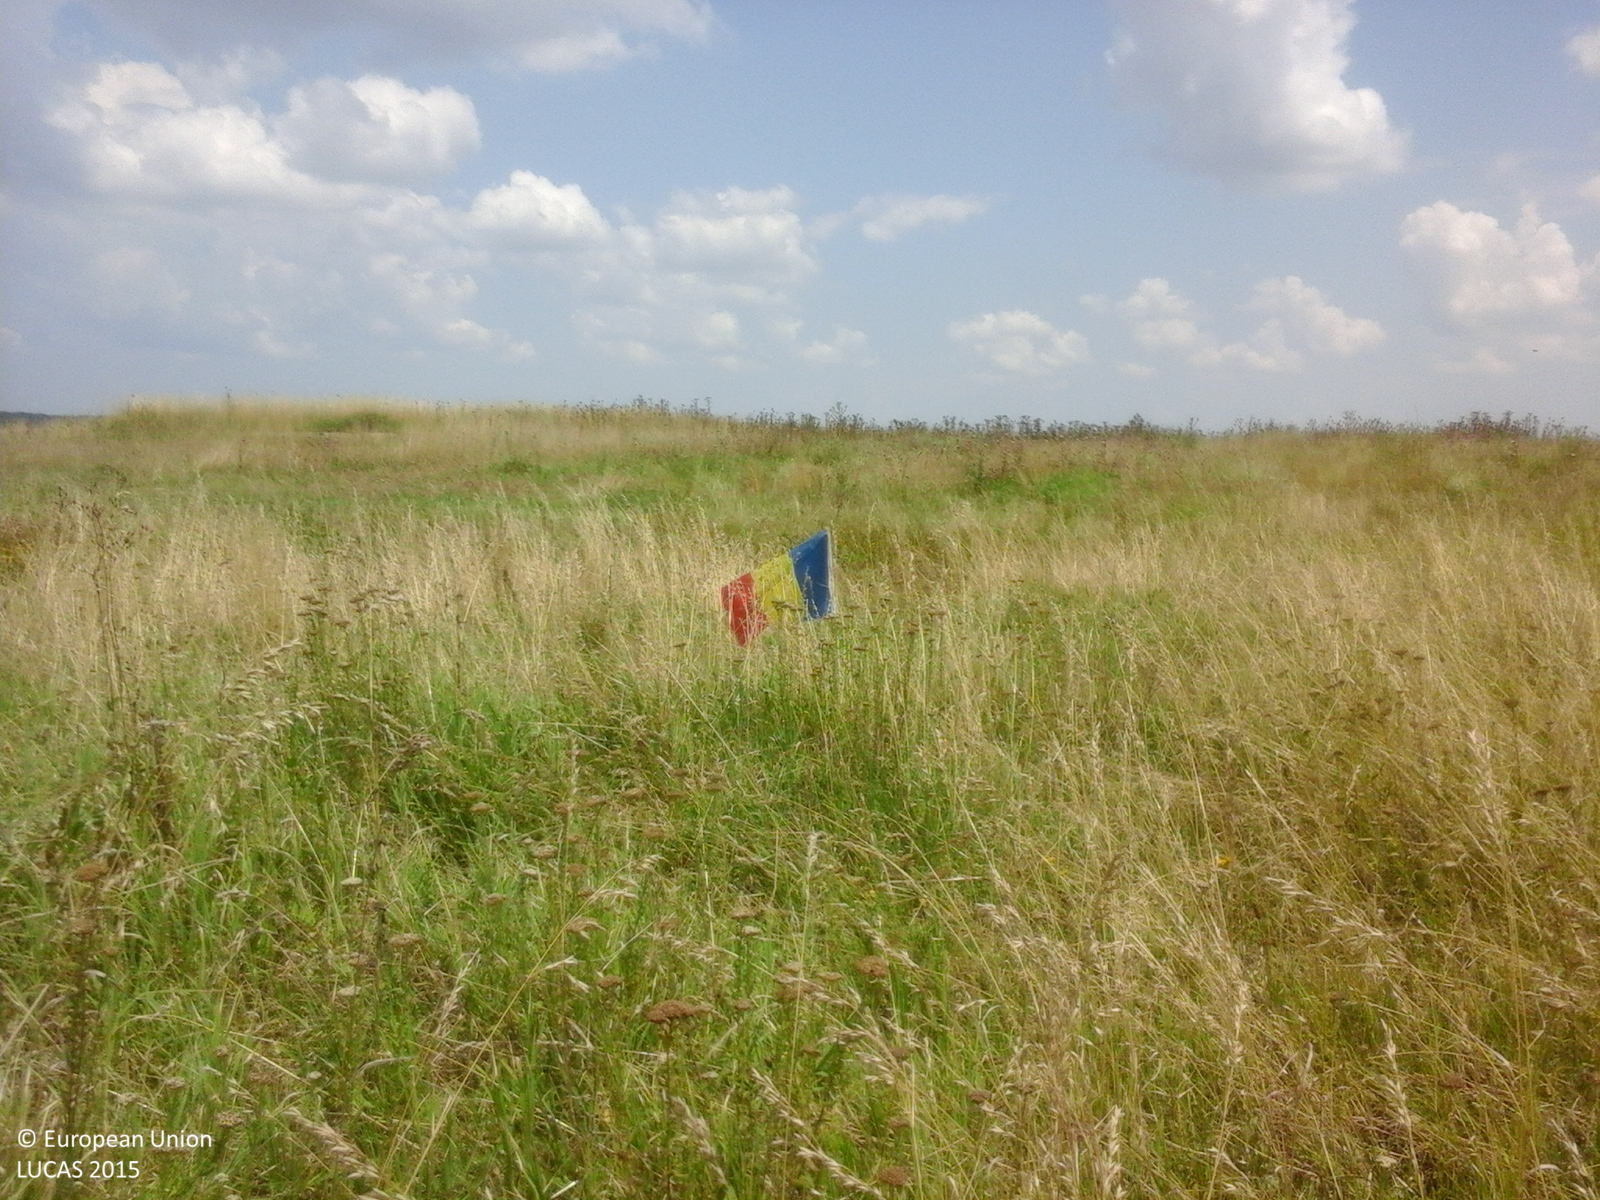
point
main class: Grassland
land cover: Grassland without tree/shrub cover
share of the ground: > 75 %
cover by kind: herbaceous plants 100 %
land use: Agriculture (excluding fallow land and kitchen gardens)
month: July
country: RO
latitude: 44.0441
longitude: 25.3471
